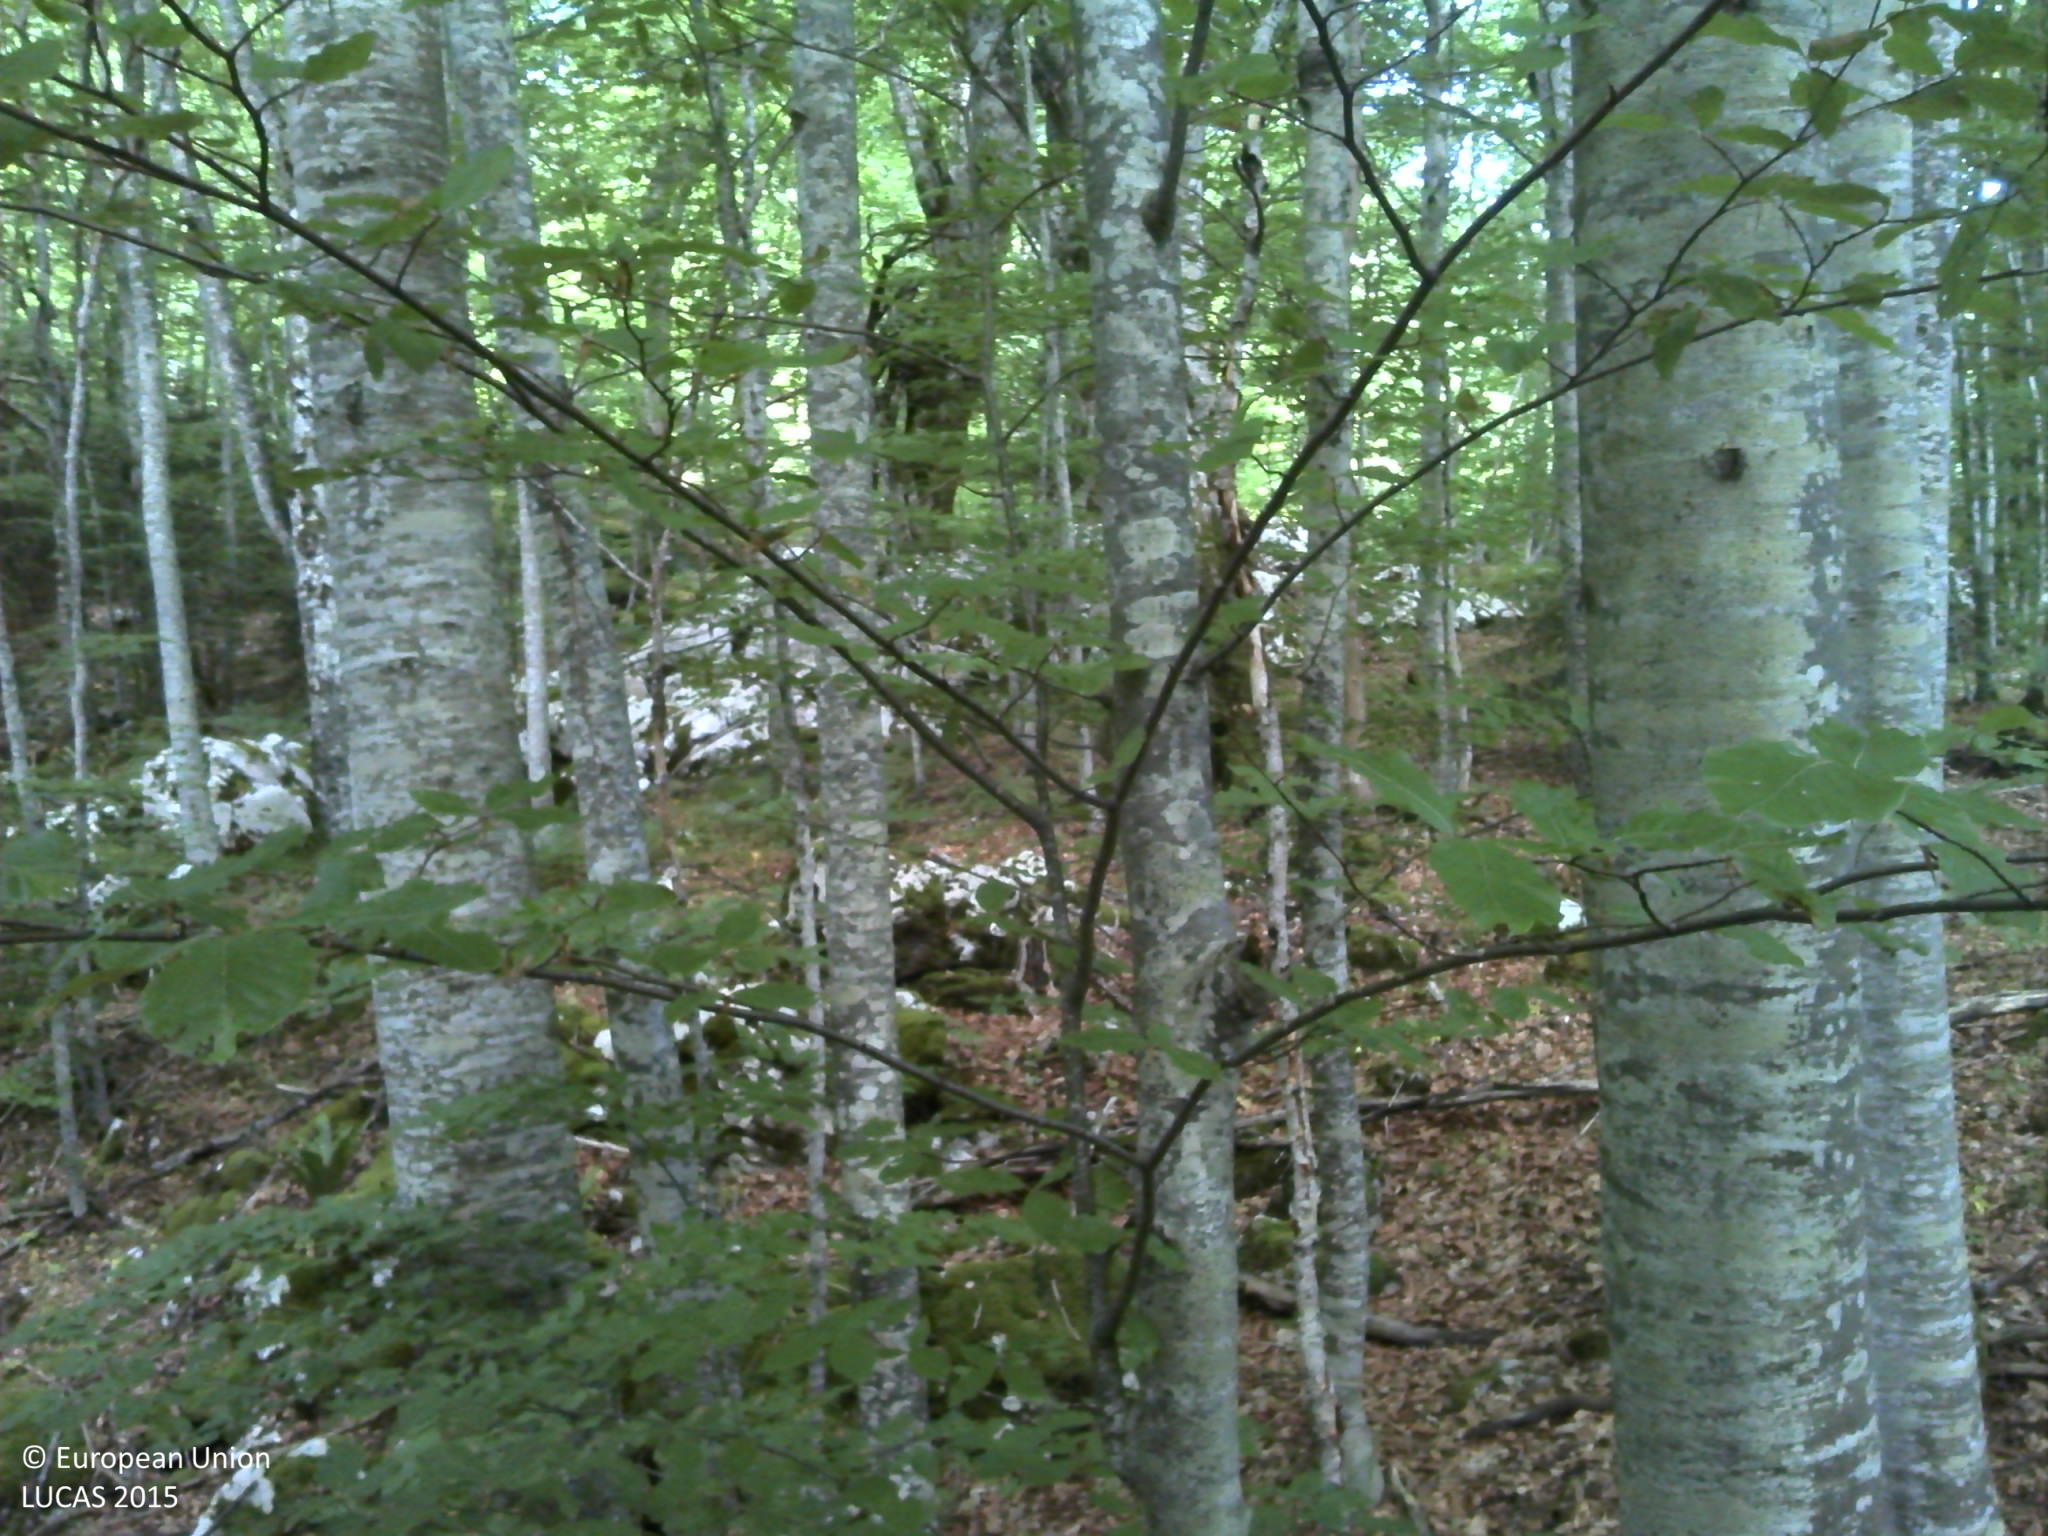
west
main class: Woodland
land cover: Broadleaved woodland
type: mountainous beech forest
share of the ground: > 75 %
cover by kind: broadleaved forest trees 90 %, consolidated bare surface 10 %
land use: Forestry
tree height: > 5 m
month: June
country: HR
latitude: 44.5983
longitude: 15.9026
